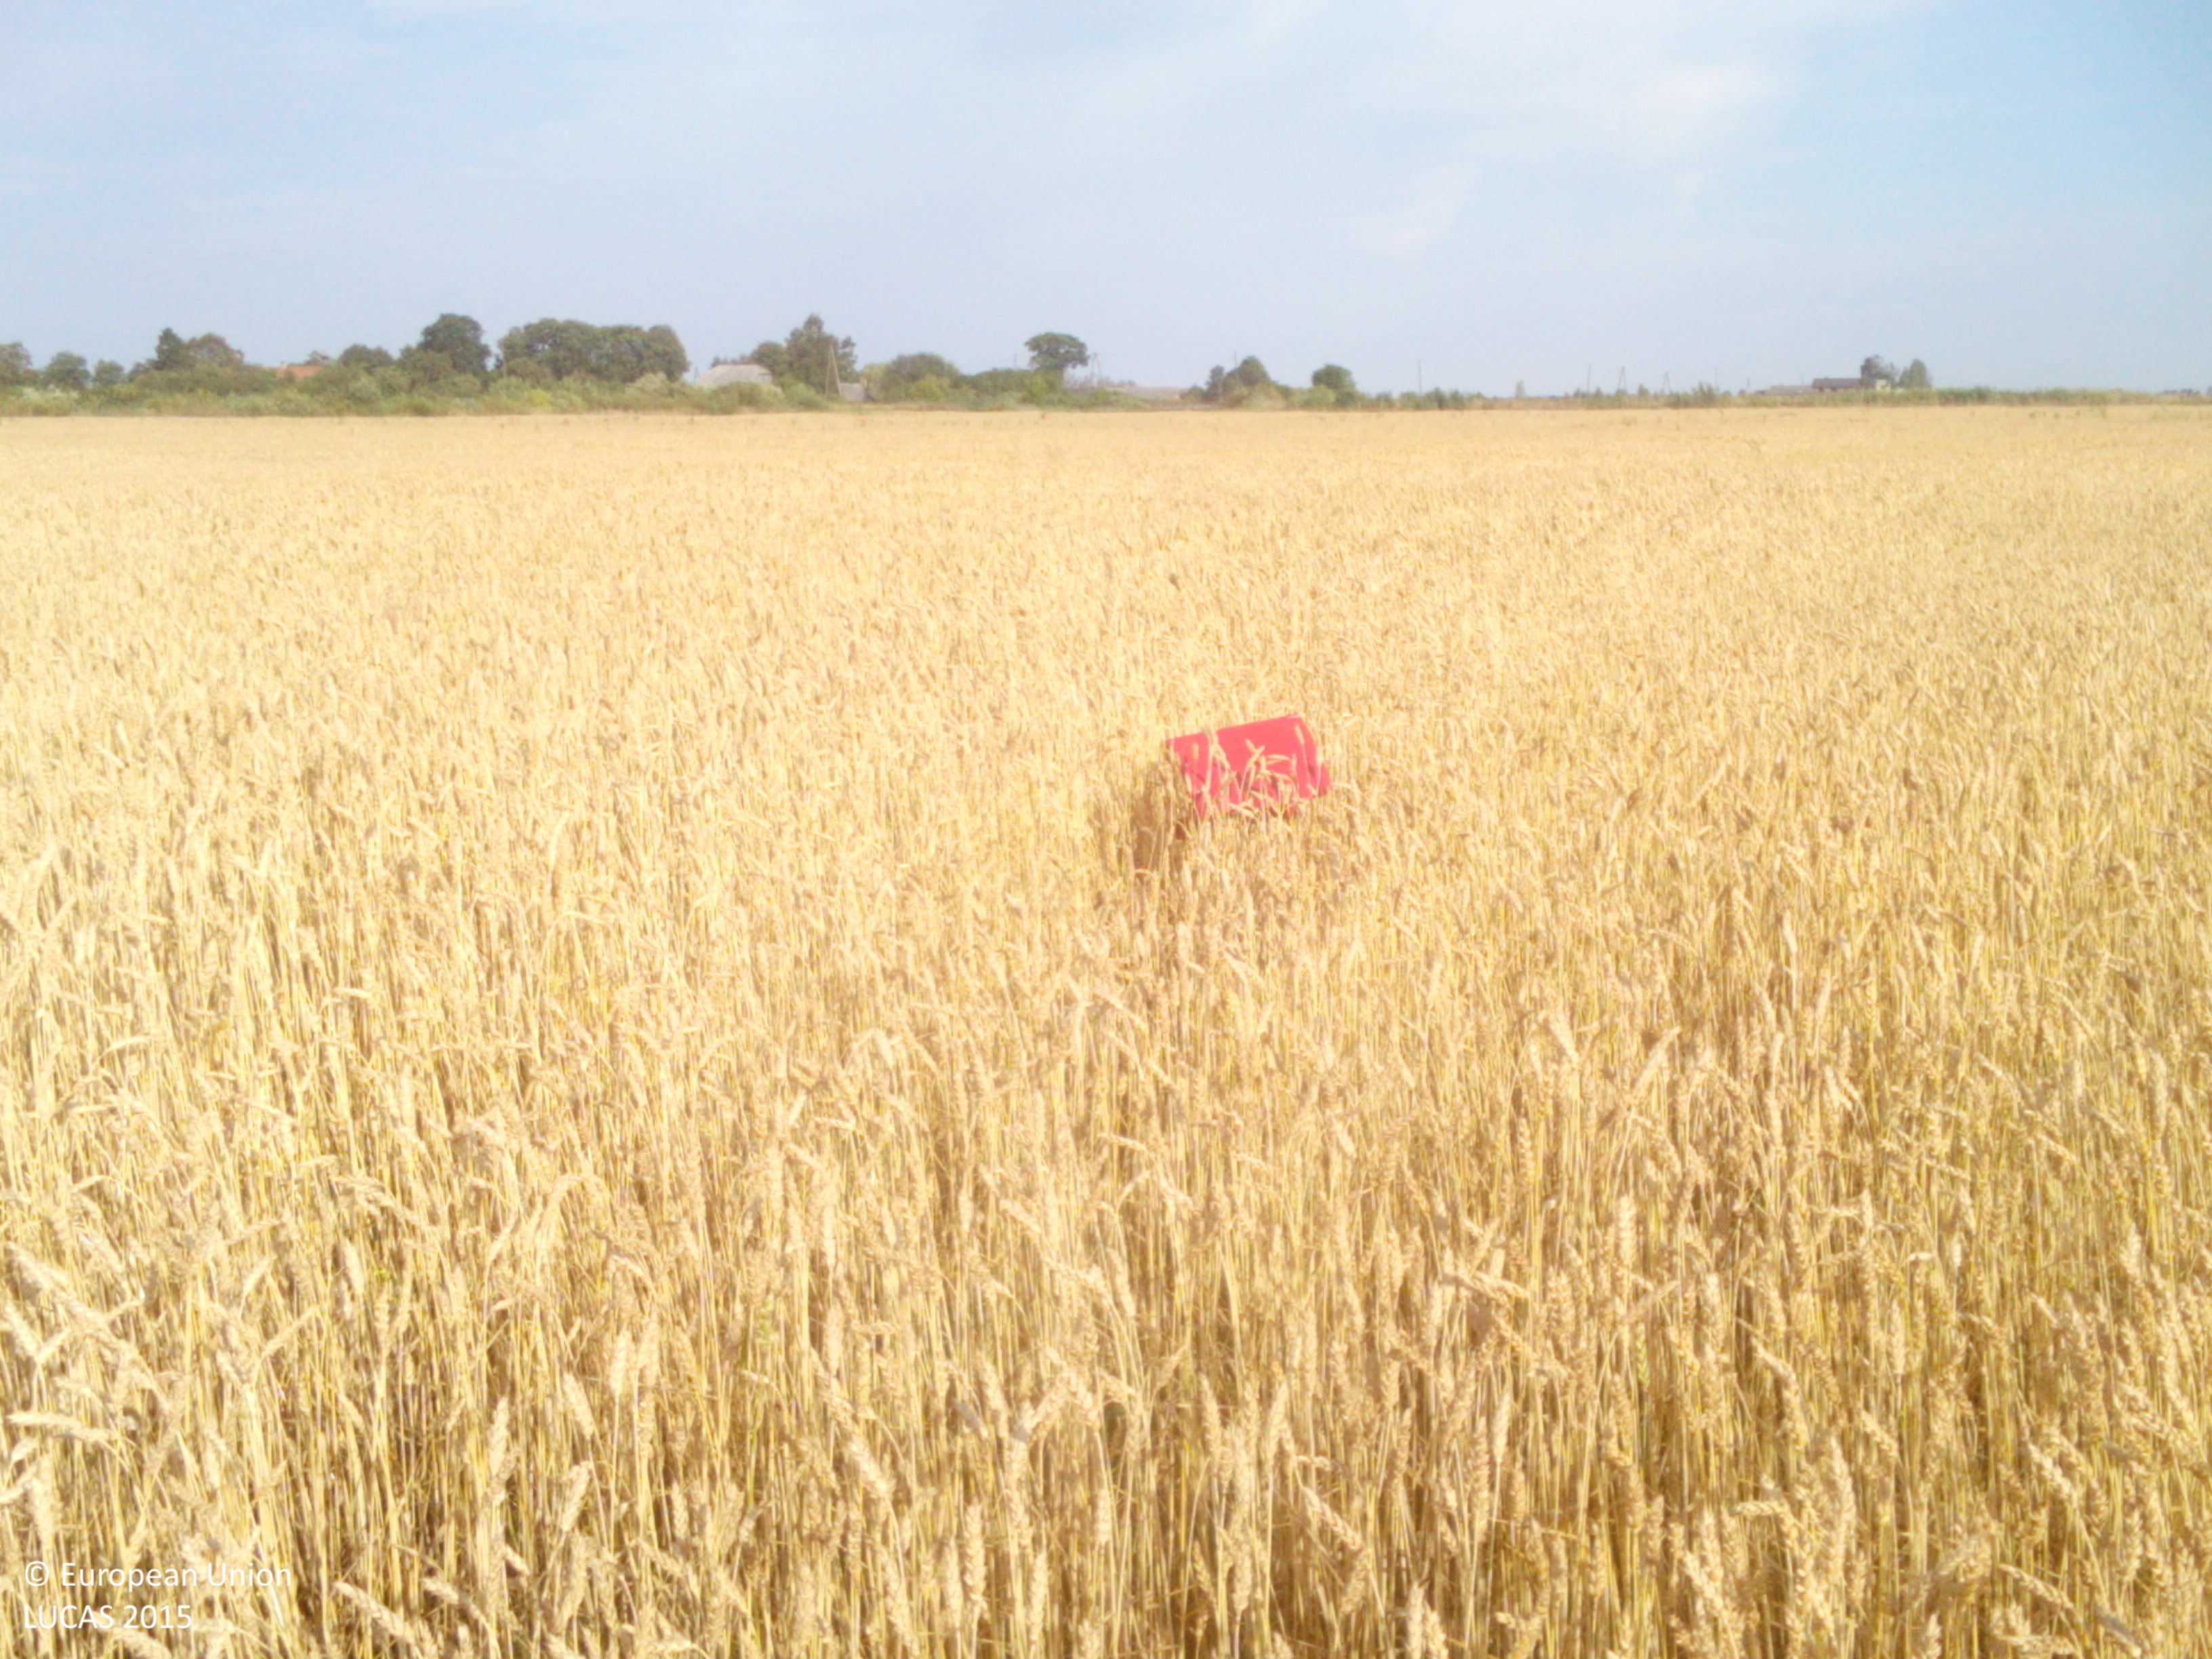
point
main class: Cropland
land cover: Common wheat
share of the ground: > 75 %
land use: Agriculture (excluding fallow land and kitchen gardens)
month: August
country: LV
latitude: 56.3798
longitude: 21.0652
